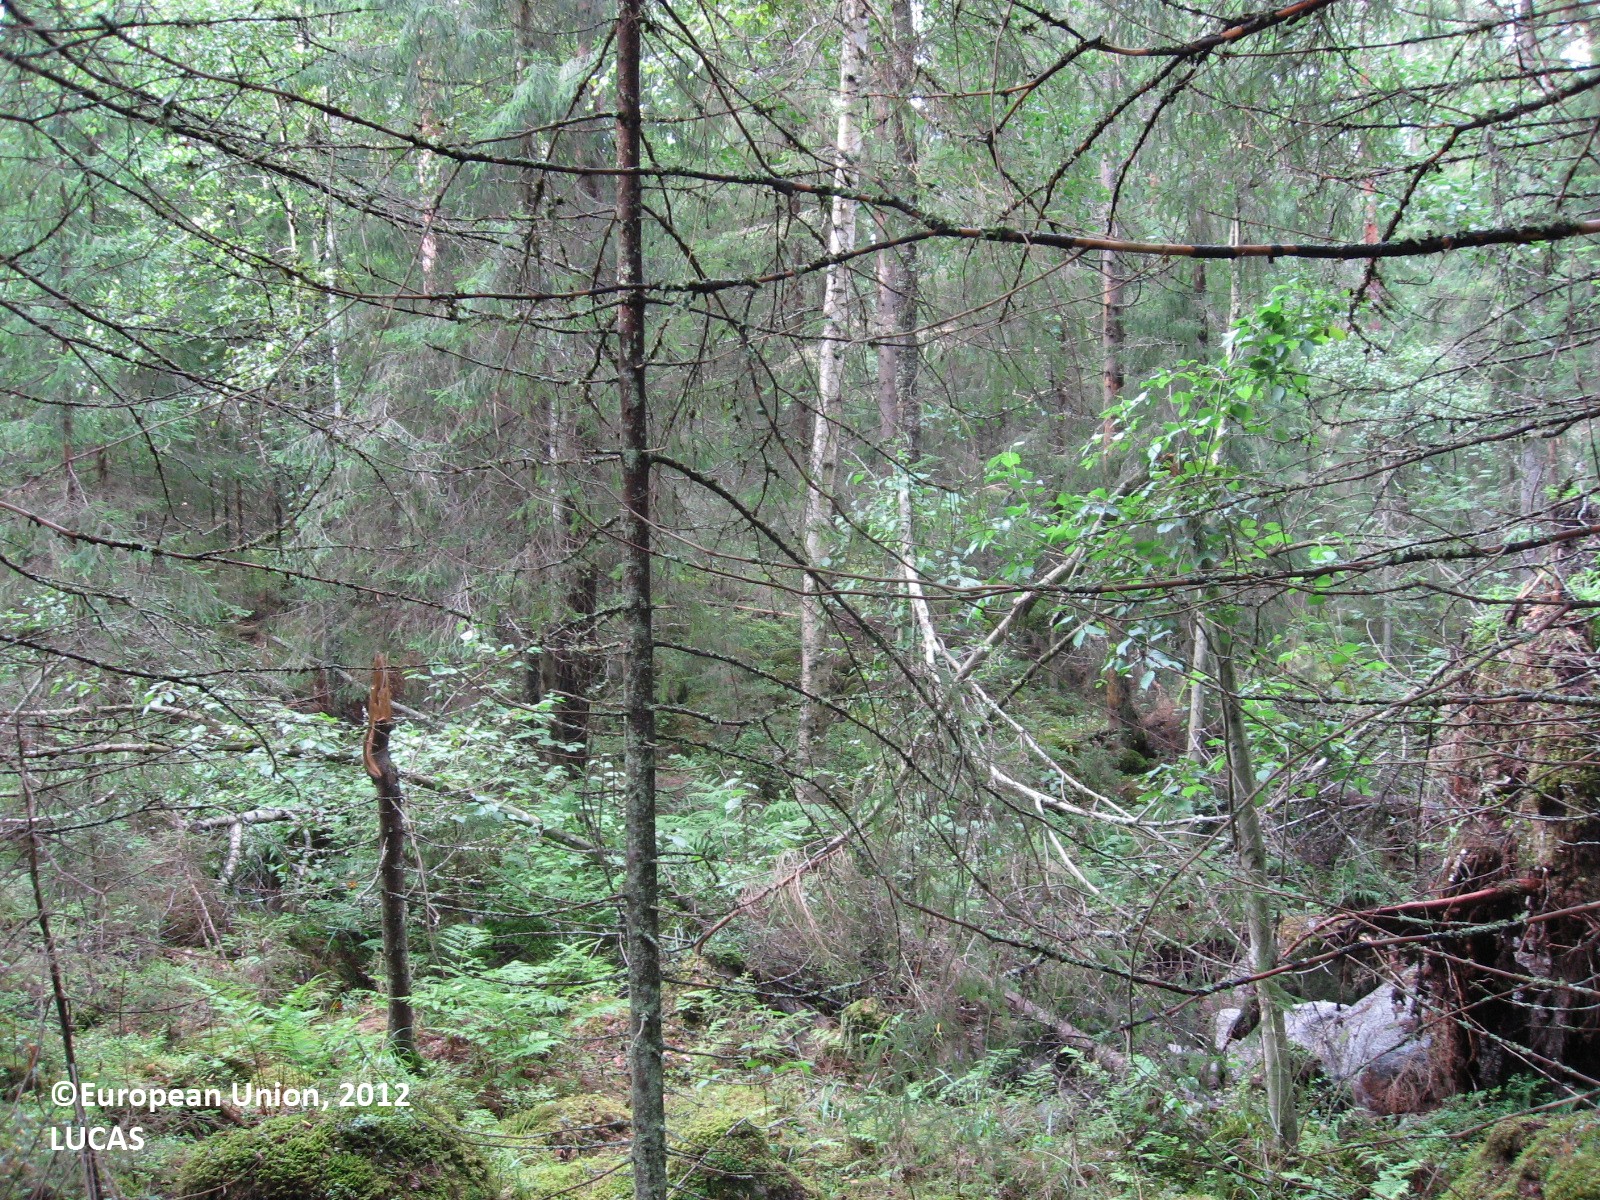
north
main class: Woodland
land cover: Spruce dominated coniferous woodland
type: boreal forest
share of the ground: > 75 %
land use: Forestry
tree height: > 5 m
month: August
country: FI
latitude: 61.1318
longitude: 24.8710
